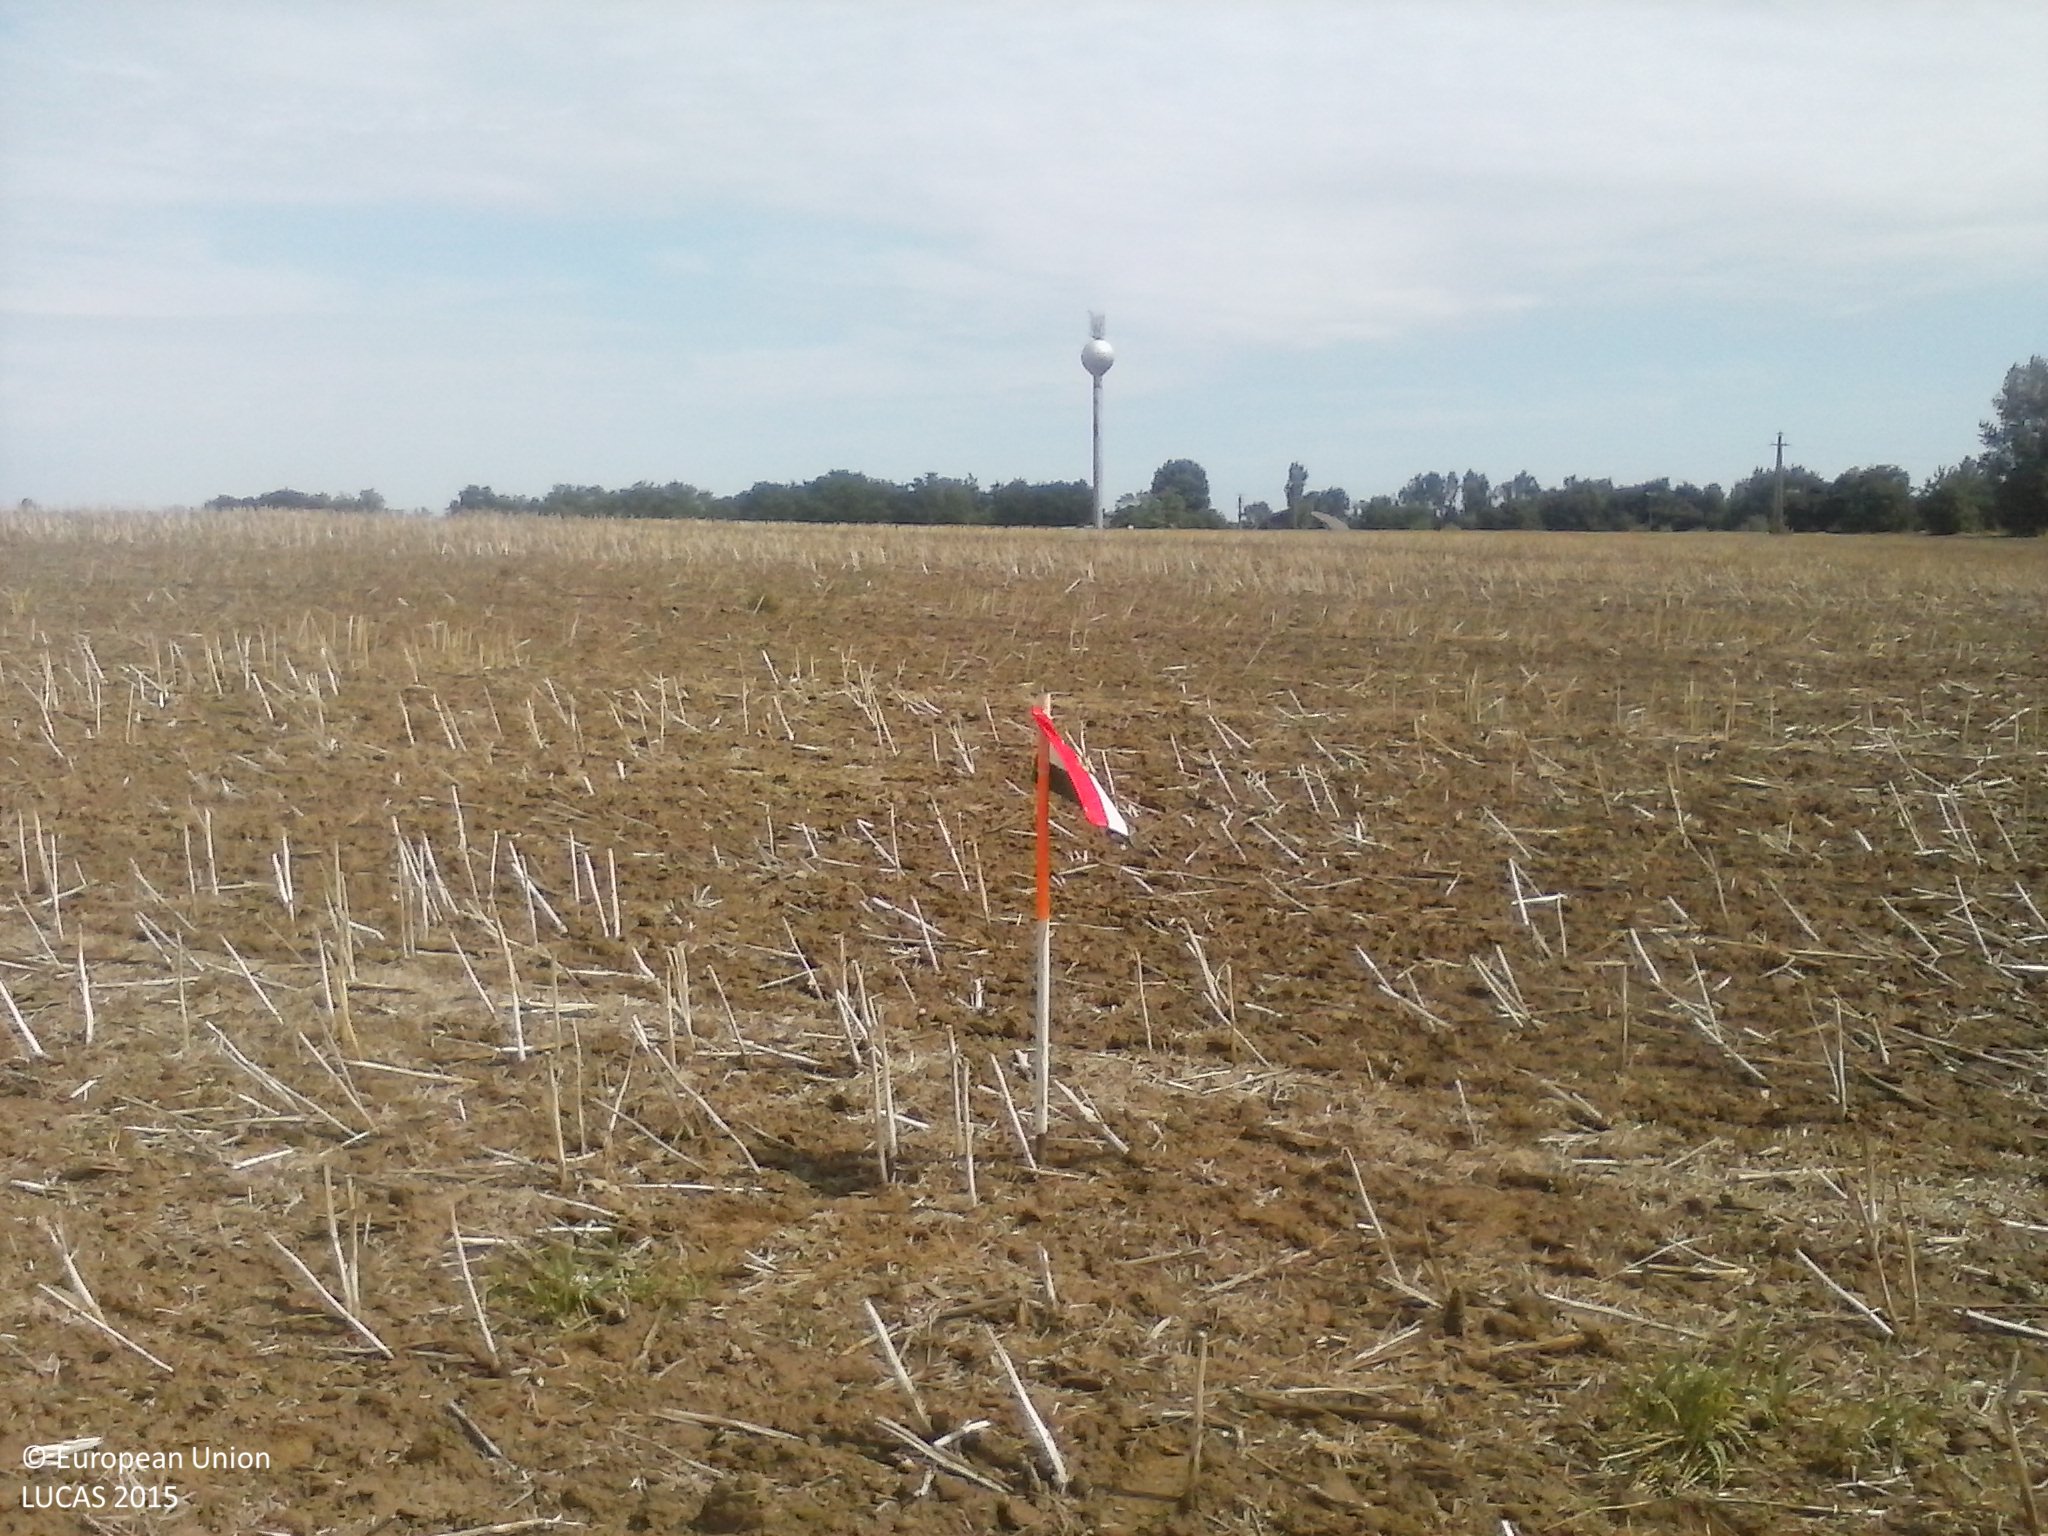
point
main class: Cropland
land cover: Rape and turnip rape
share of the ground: < 10 %
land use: Agriculture (excluding fallow land and kitchen gardens)
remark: Harvested field
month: July
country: HU
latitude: 46.1061
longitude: 17.2344
